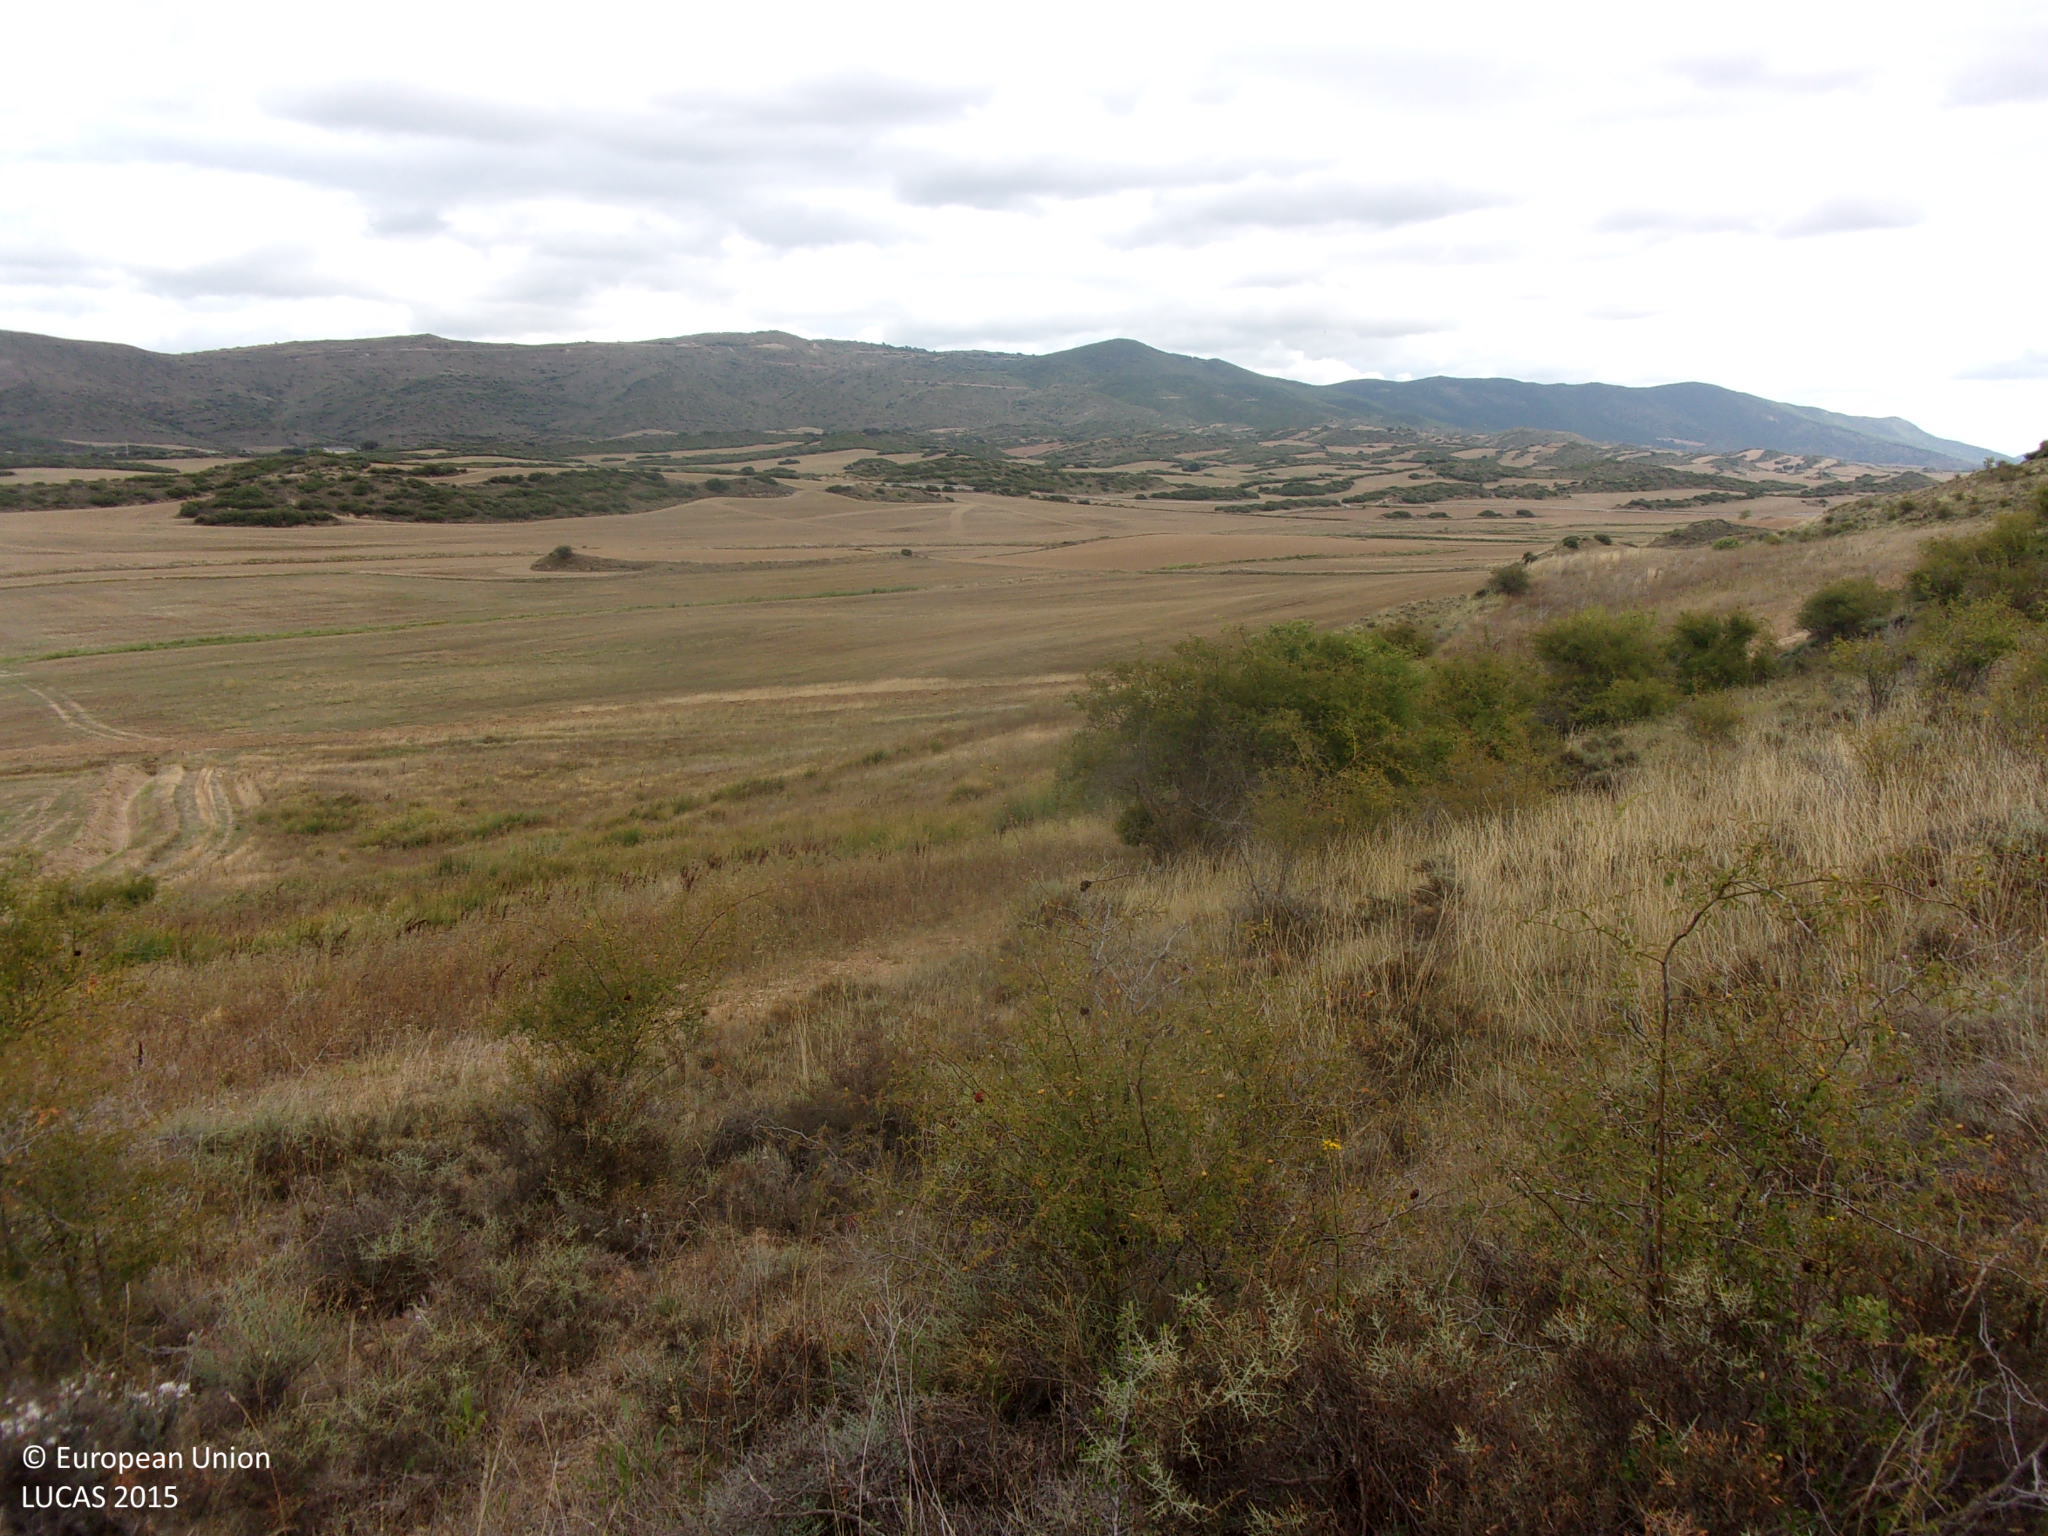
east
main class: Shrubland
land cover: Shrubland without tree cover
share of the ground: 50 - 75 %
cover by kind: shrubs 60 %, herbaceous plants 40 %
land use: Semi-natural and natural areas not in use
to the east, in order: Shrubland without tree cover; Spontaneously vegetated surfaces; Shrubland without tree cover; Spontaneously vegetated surfaces; Shrubland without tree cover; Common wheat; Ditches and canals; Common wheat
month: August
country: ES
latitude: 42.5410
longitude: -1.1982
